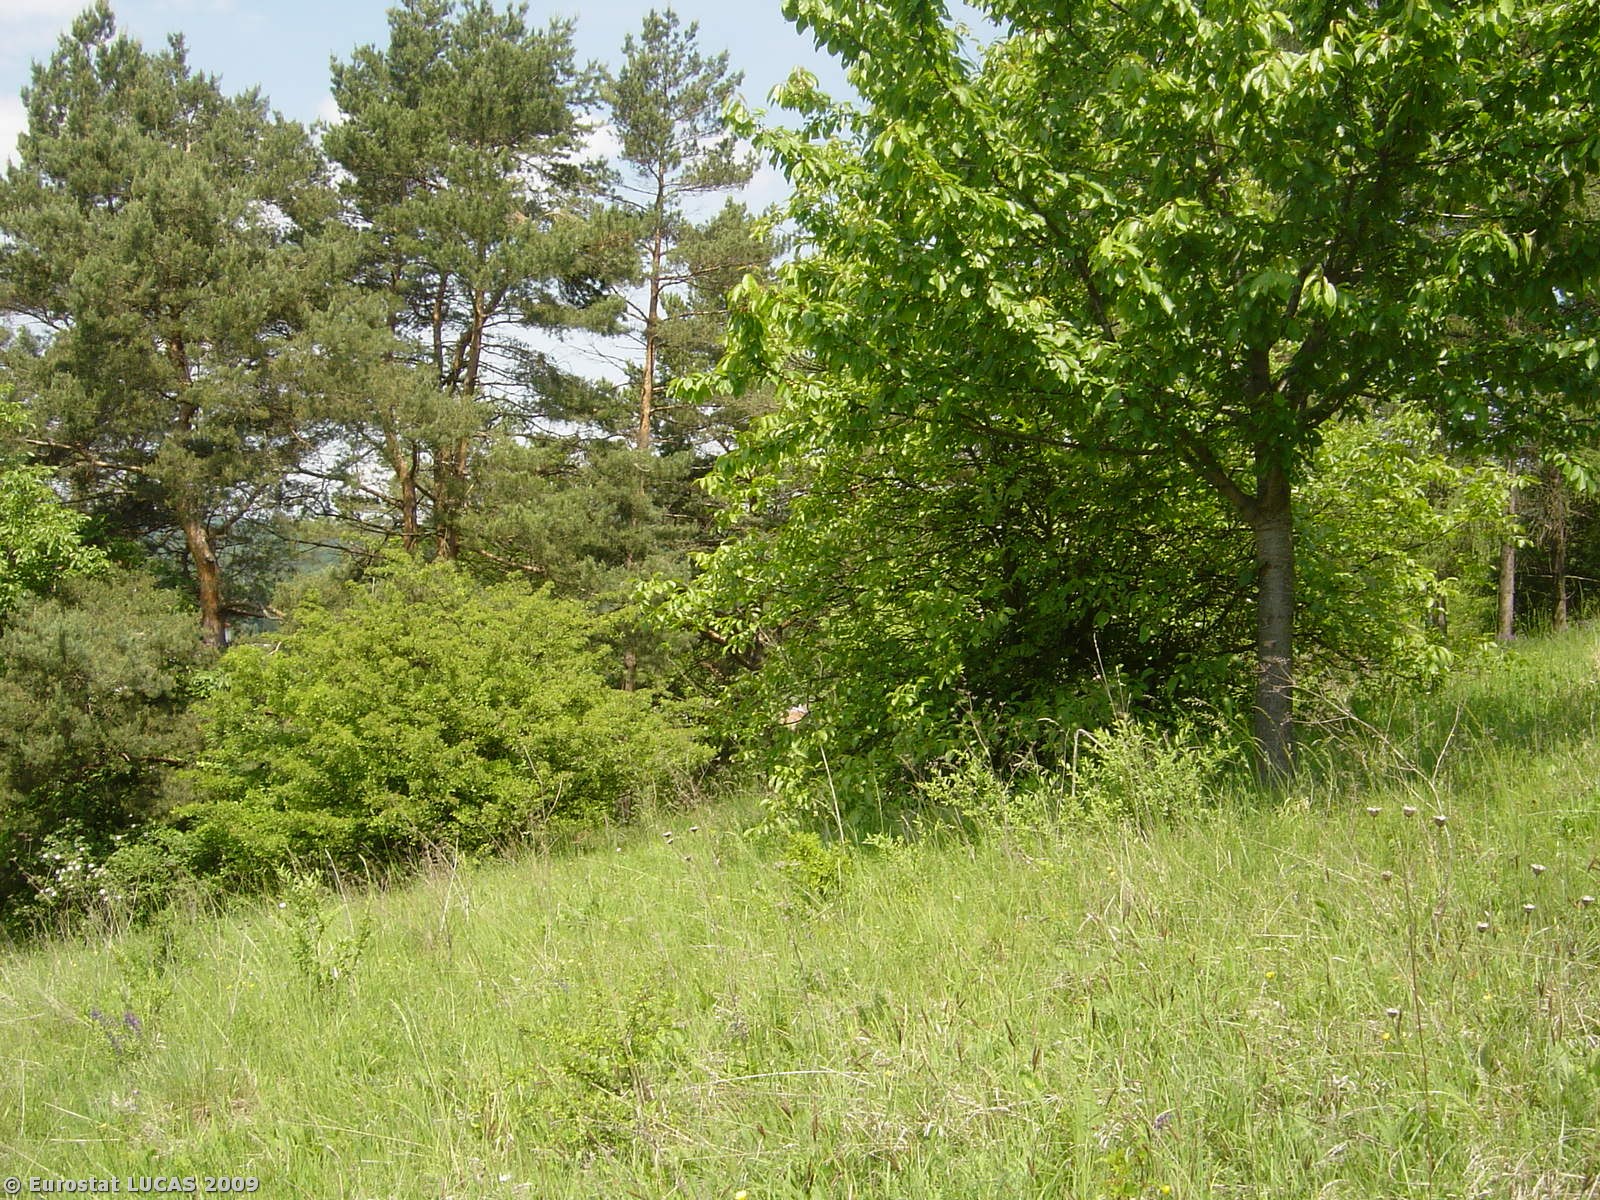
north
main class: Grassland
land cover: Grassland with sparse tree/shrub cover
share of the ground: > 75 %
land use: Agriculture (excluding fallow land and kitchen gardens)
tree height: > 5 m
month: May
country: CZ
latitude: 49.0628
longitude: 17.0576
